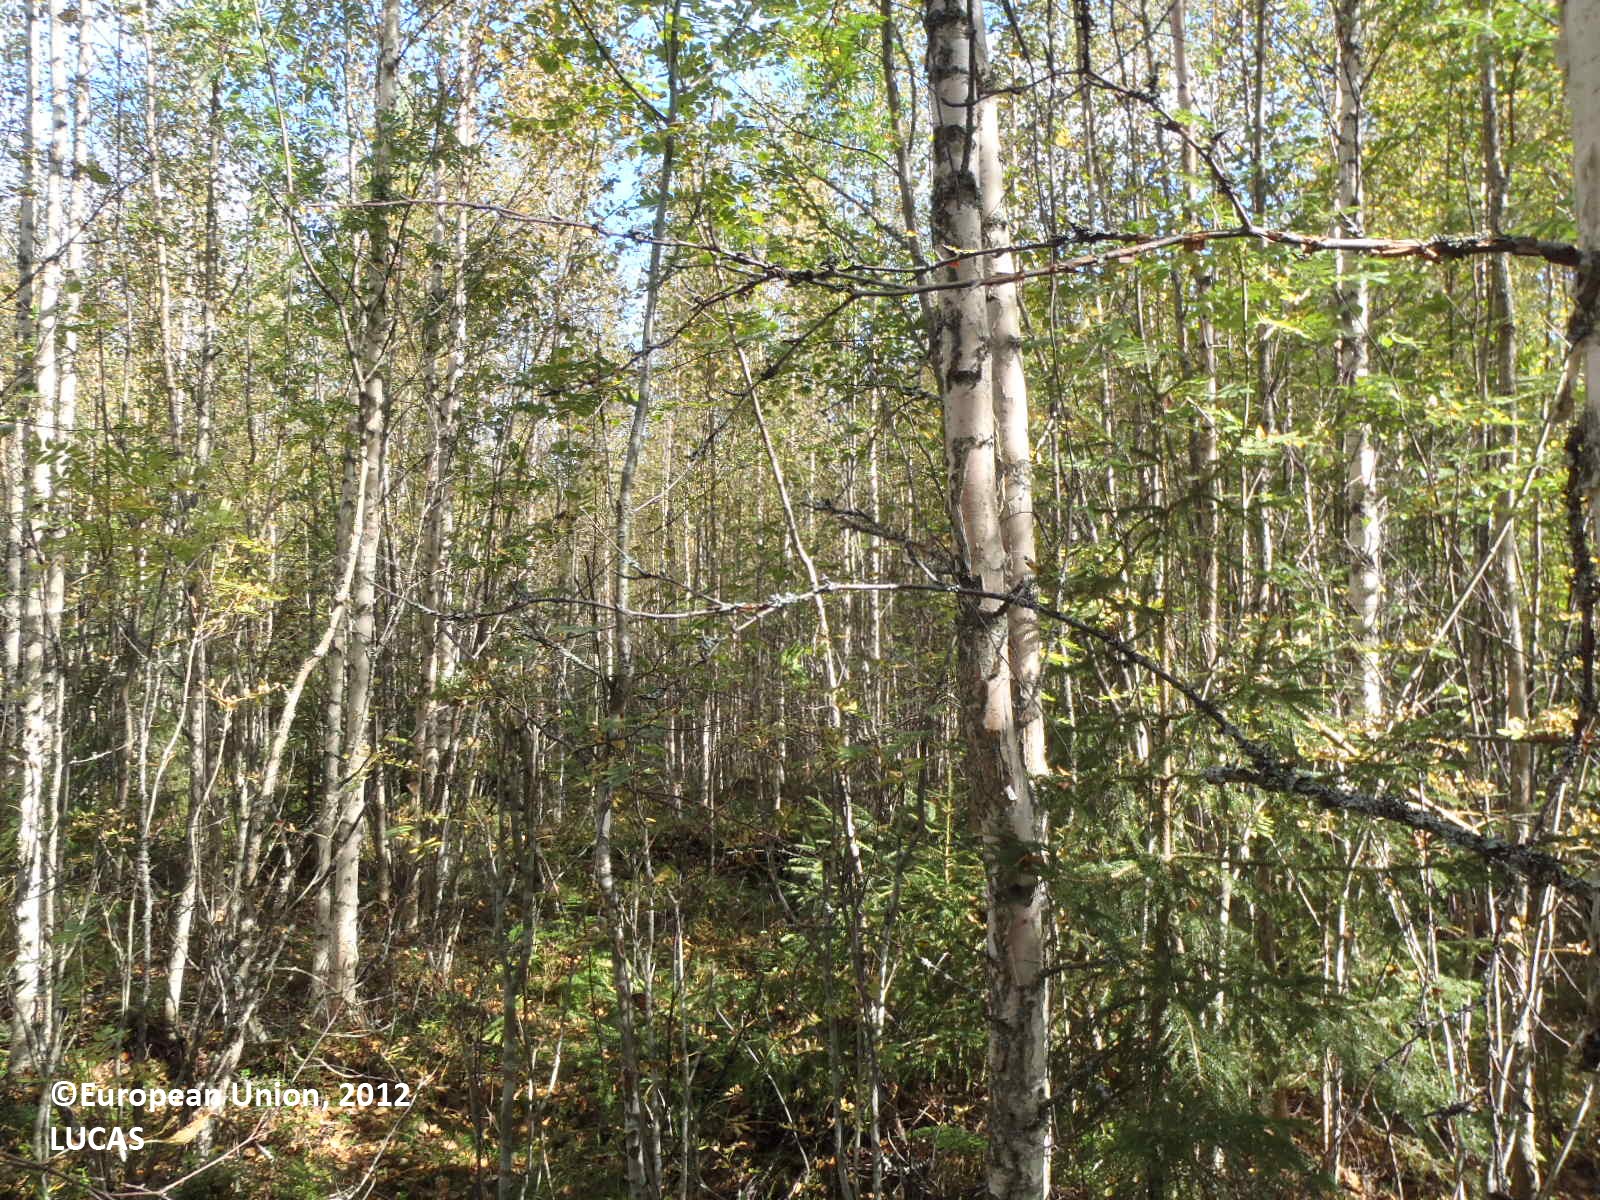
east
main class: Woodland
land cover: Broadleaved woodland
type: boreal forest
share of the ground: > 75 %
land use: Forestry
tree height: > 5 m
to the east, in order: Broadleaved woodland; Spruce dominated mixed woodland; Pine dominated coniferous woodland; Ditches and canals; Pine dominated mixed woodland; Ditches and canals; Pine dominated mixed woodland; Spruce dominated mixed woodland; Ditches and canals; Spruce dominated mixed woodland; Ditches and canals; Spruce dominated mixed woodland; Ditches and canals; Spruce dominated mixed woodland; Ditches and canals; Spruce dominated mixed woodland; Ditches and canals; Spruce dominated mixed woodland
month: September
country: FI
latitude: 61.5166
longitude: 22.5641
